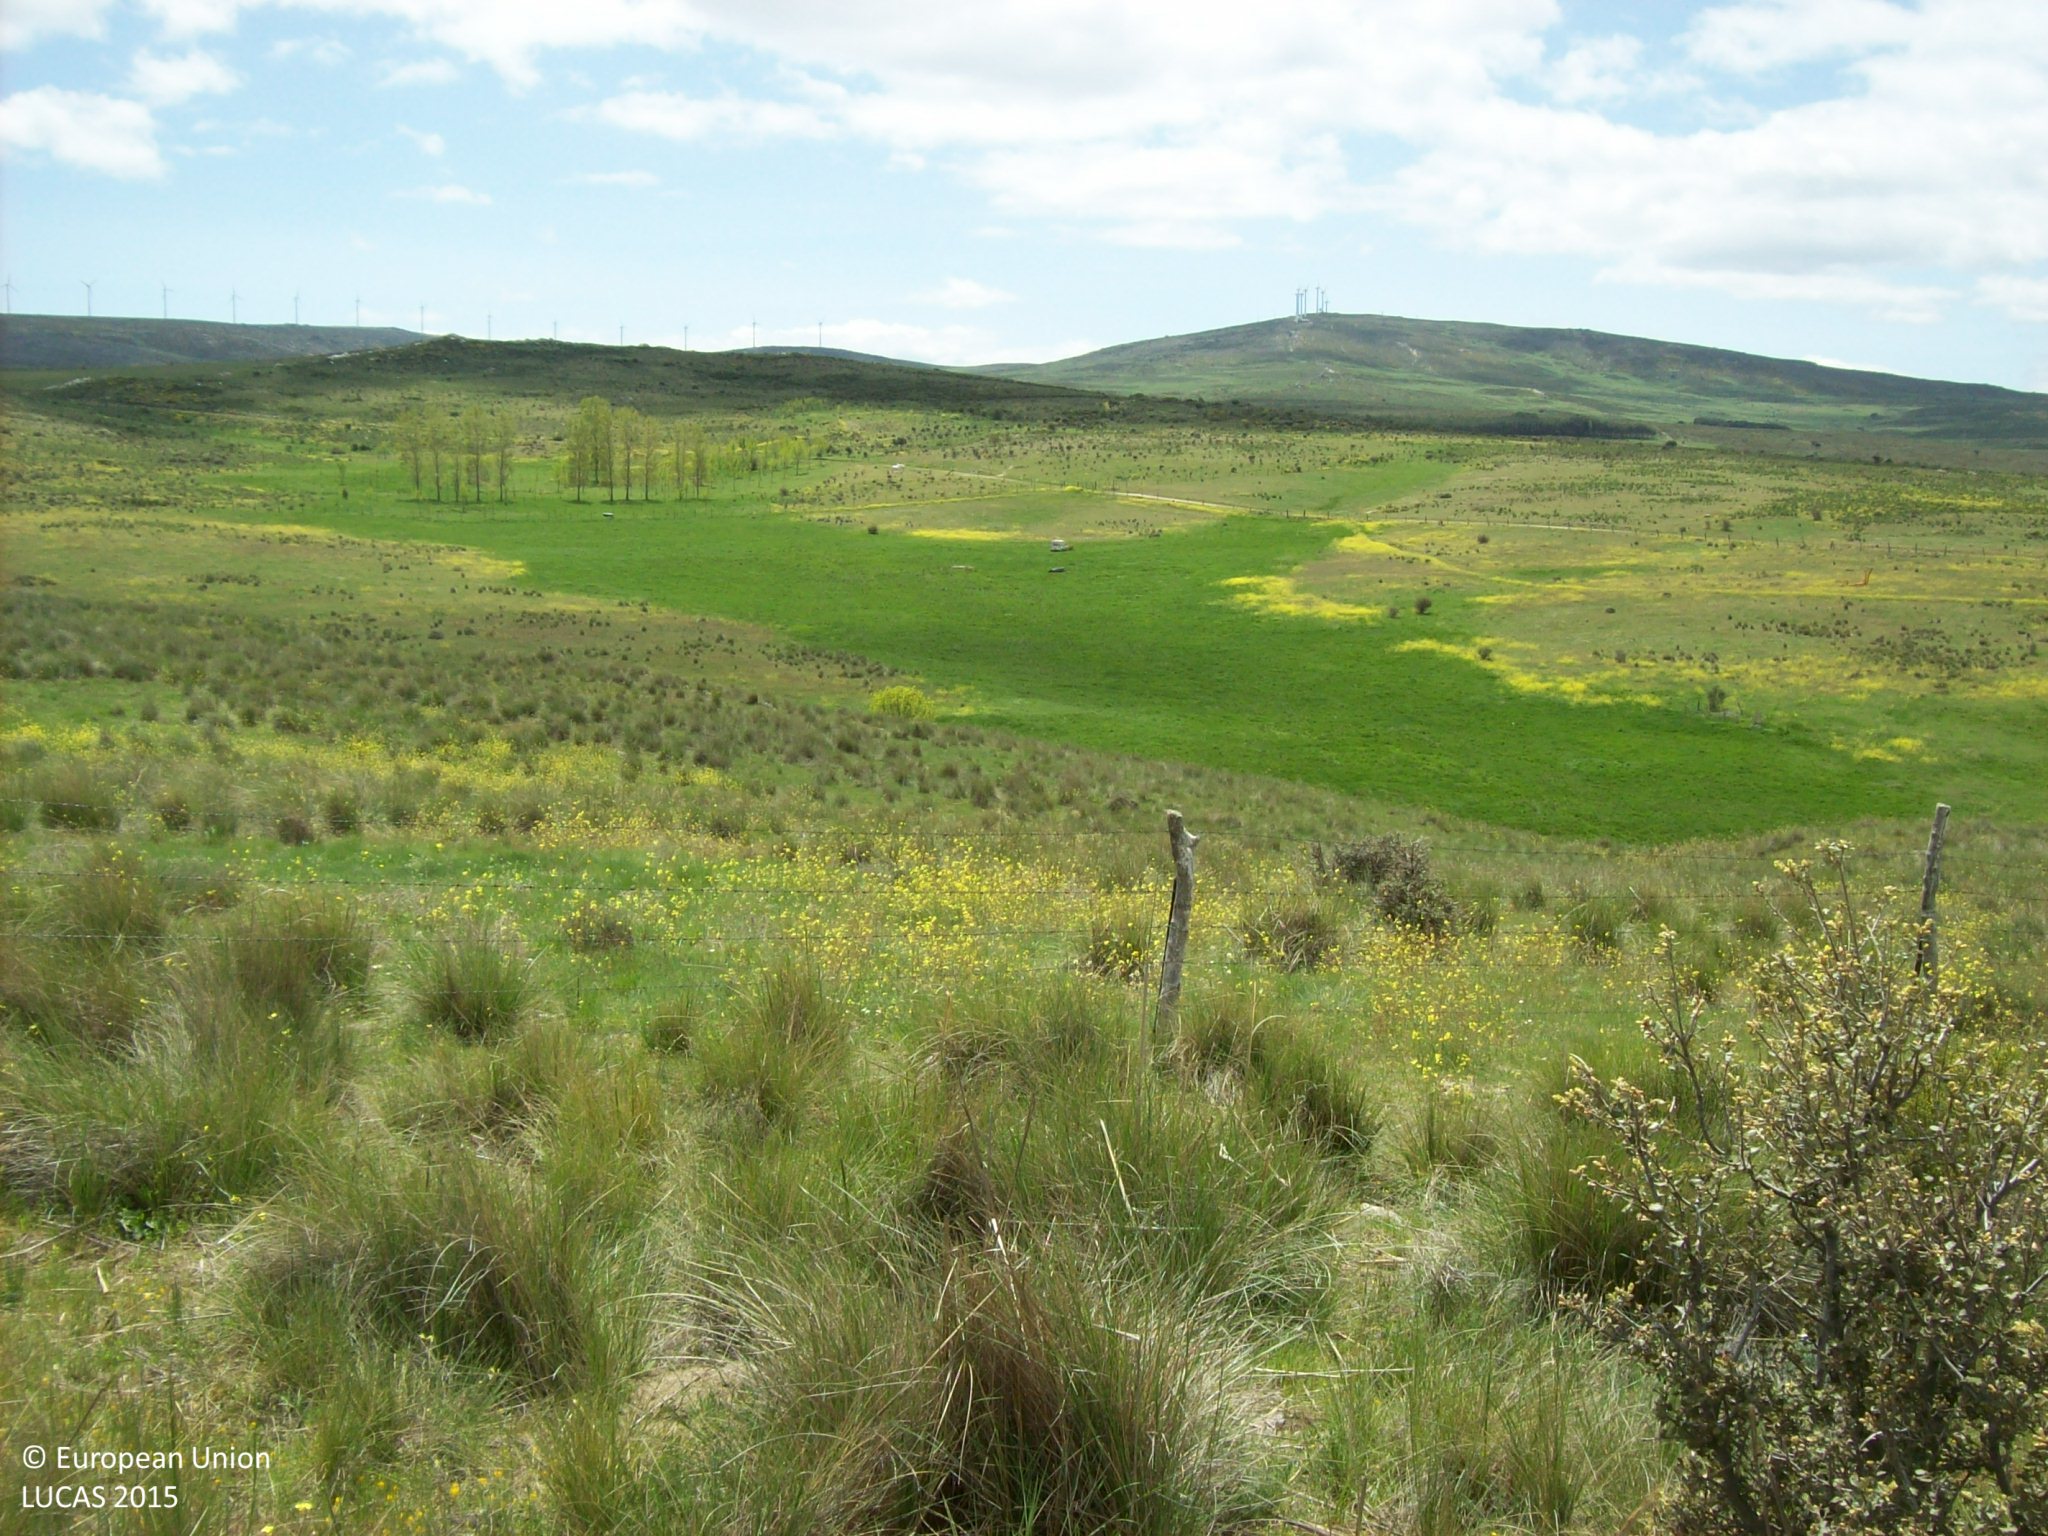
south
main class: Grassland
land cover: Grassland without tree/shrub cover
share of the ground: > 75 %
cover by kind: herbaceous plants 95 %, shrubs 5 %
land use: Agriculture (excluding fallow land and kitchen gardens)
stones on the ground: < 10 %
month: May
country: ES
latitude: 40.6701
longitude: -4.4965
